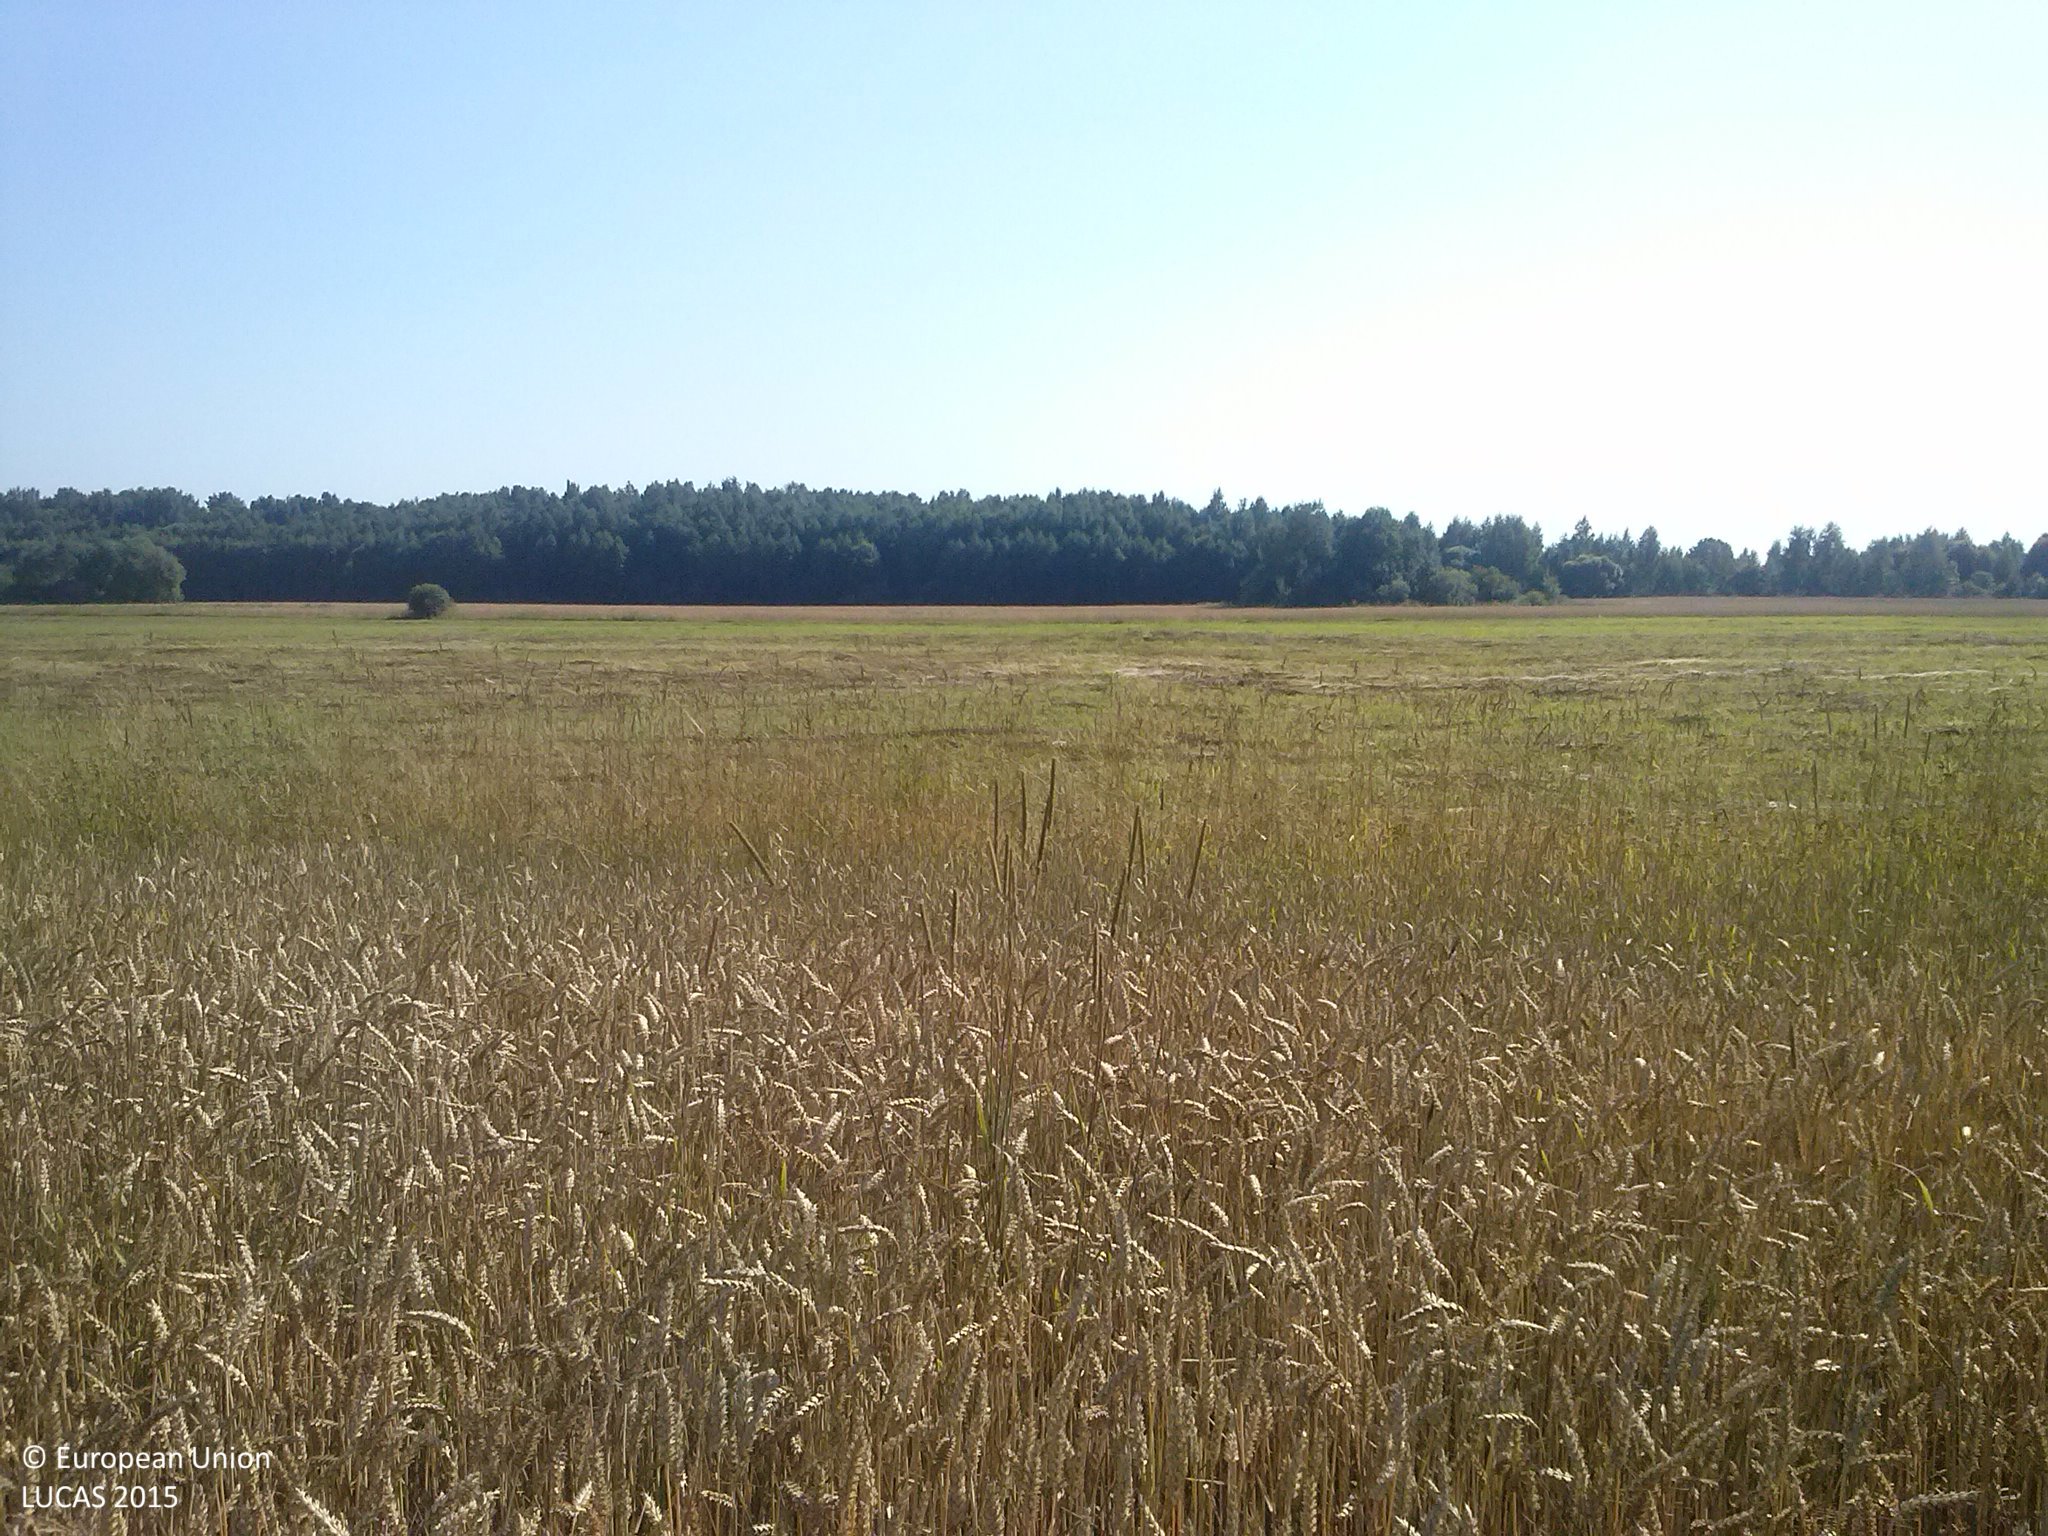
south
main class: Cropland
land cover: Common wheat
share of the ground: > 75 %
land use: Agriculture (excluding fallow land and kitchen gardens)
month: August
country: LV
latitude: 56.6998
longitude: 27.8103
